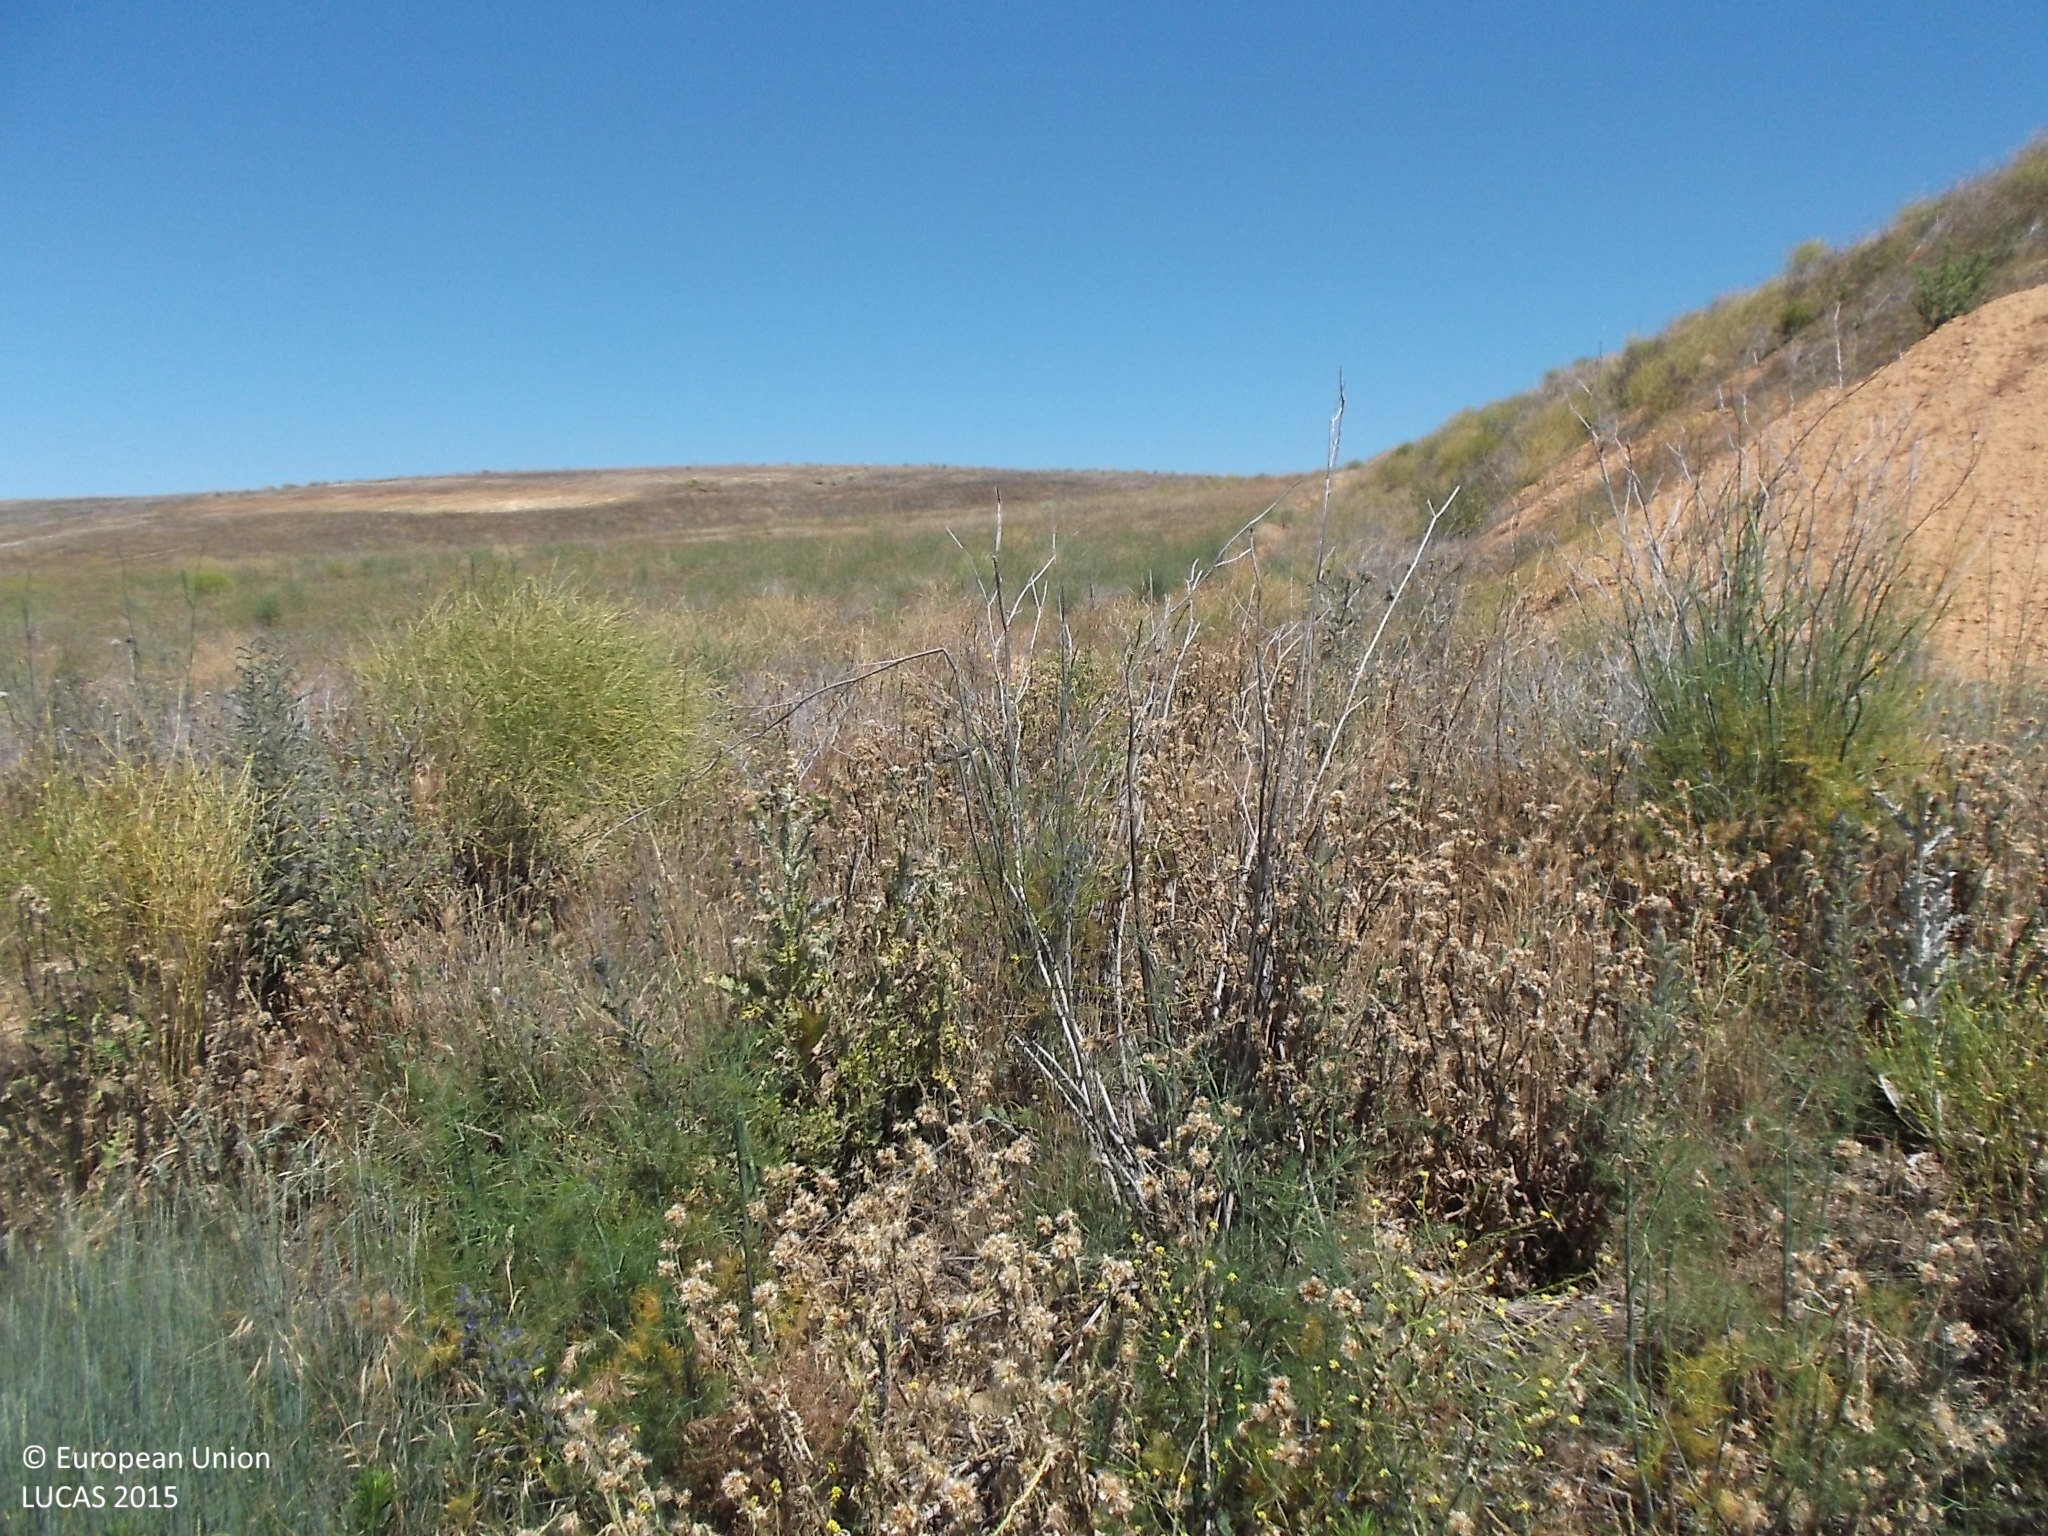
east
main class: Cropland
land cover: Common wheat
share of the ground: > 75 %
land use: Agriculture (excluding fallow land and kitchen gardens)
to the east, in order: Common wheat; Ditches and canals; Spontaneously vegetated surfaces
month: June
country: ES
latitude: 41.4411
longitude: -5.3376
